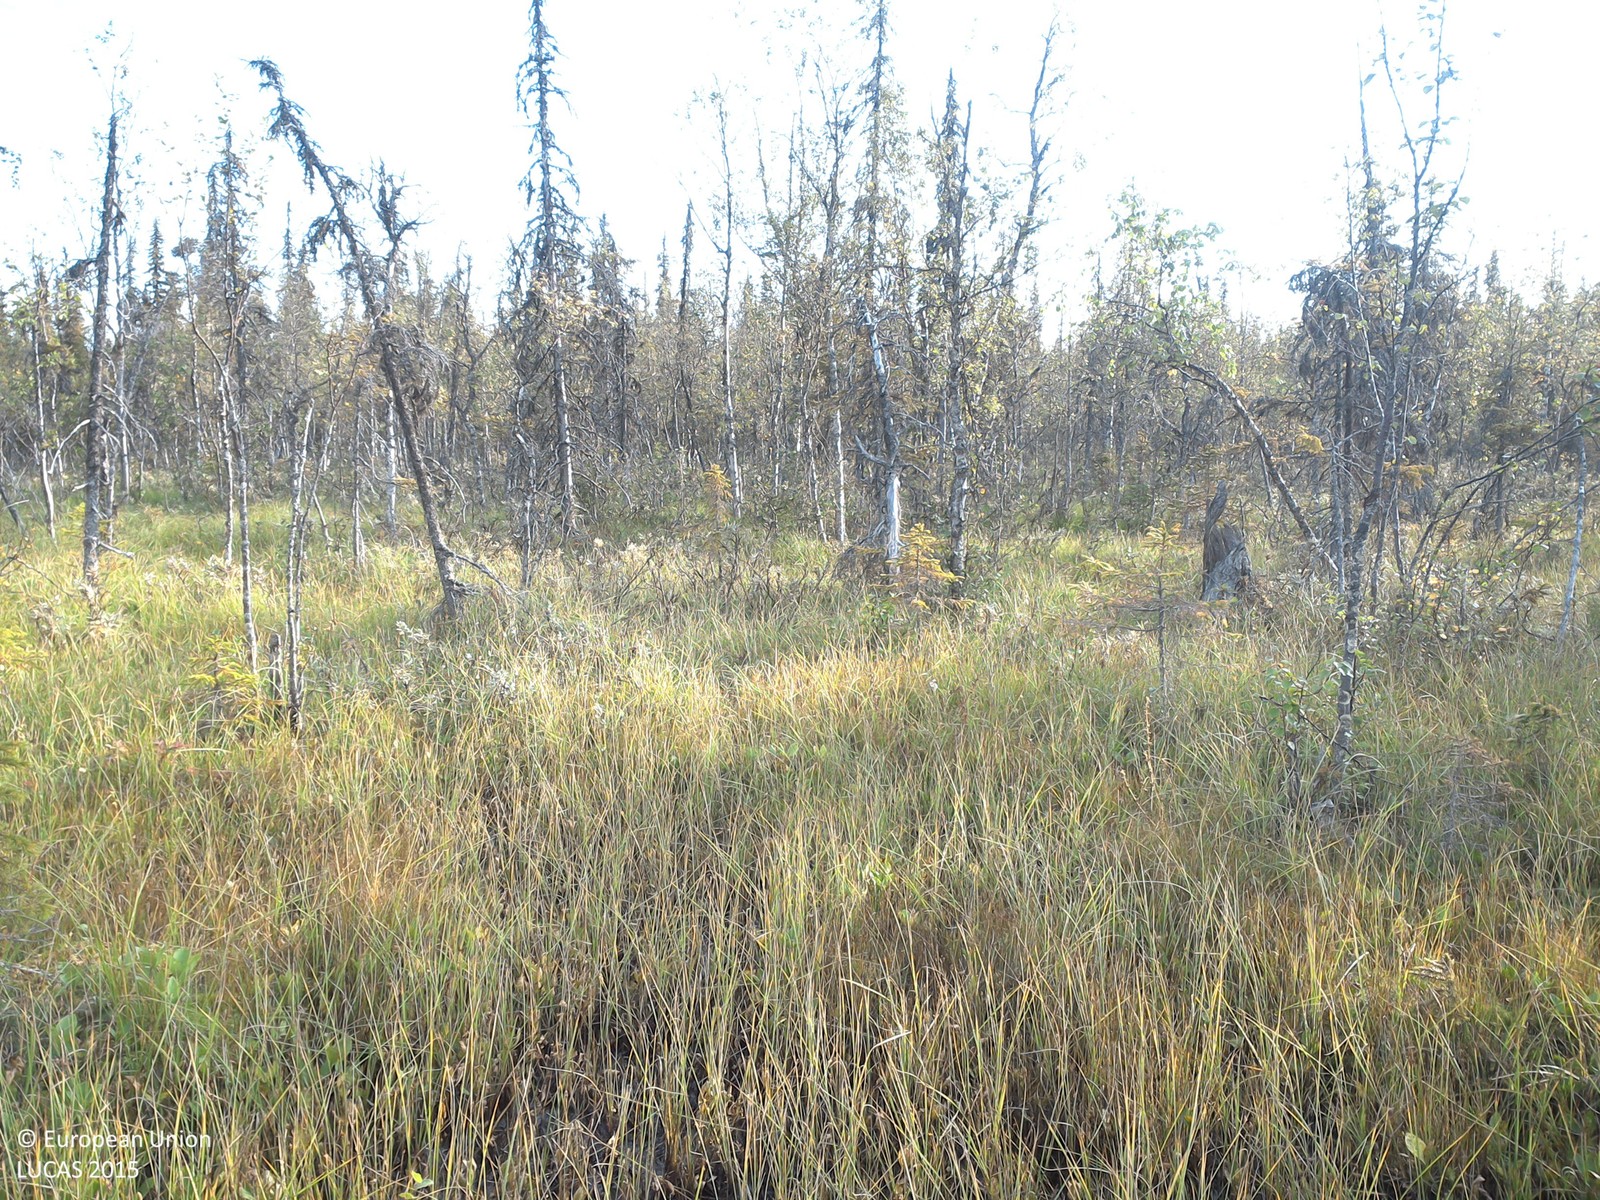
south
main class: Woodland
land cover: Other mixed woodland
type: mire and swamp forests
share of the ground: 10 - 25 %
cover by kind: herbaceous plants 55 %, lichens and mosses 20 %, coniferous forest trees 10 %, shrubs 10 %, broadleaved forest trees 5 %
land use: Semi-natural and natural areas not in use
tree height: > 5 m
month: August
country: SE
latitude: 67.2615
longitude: 21.9890
